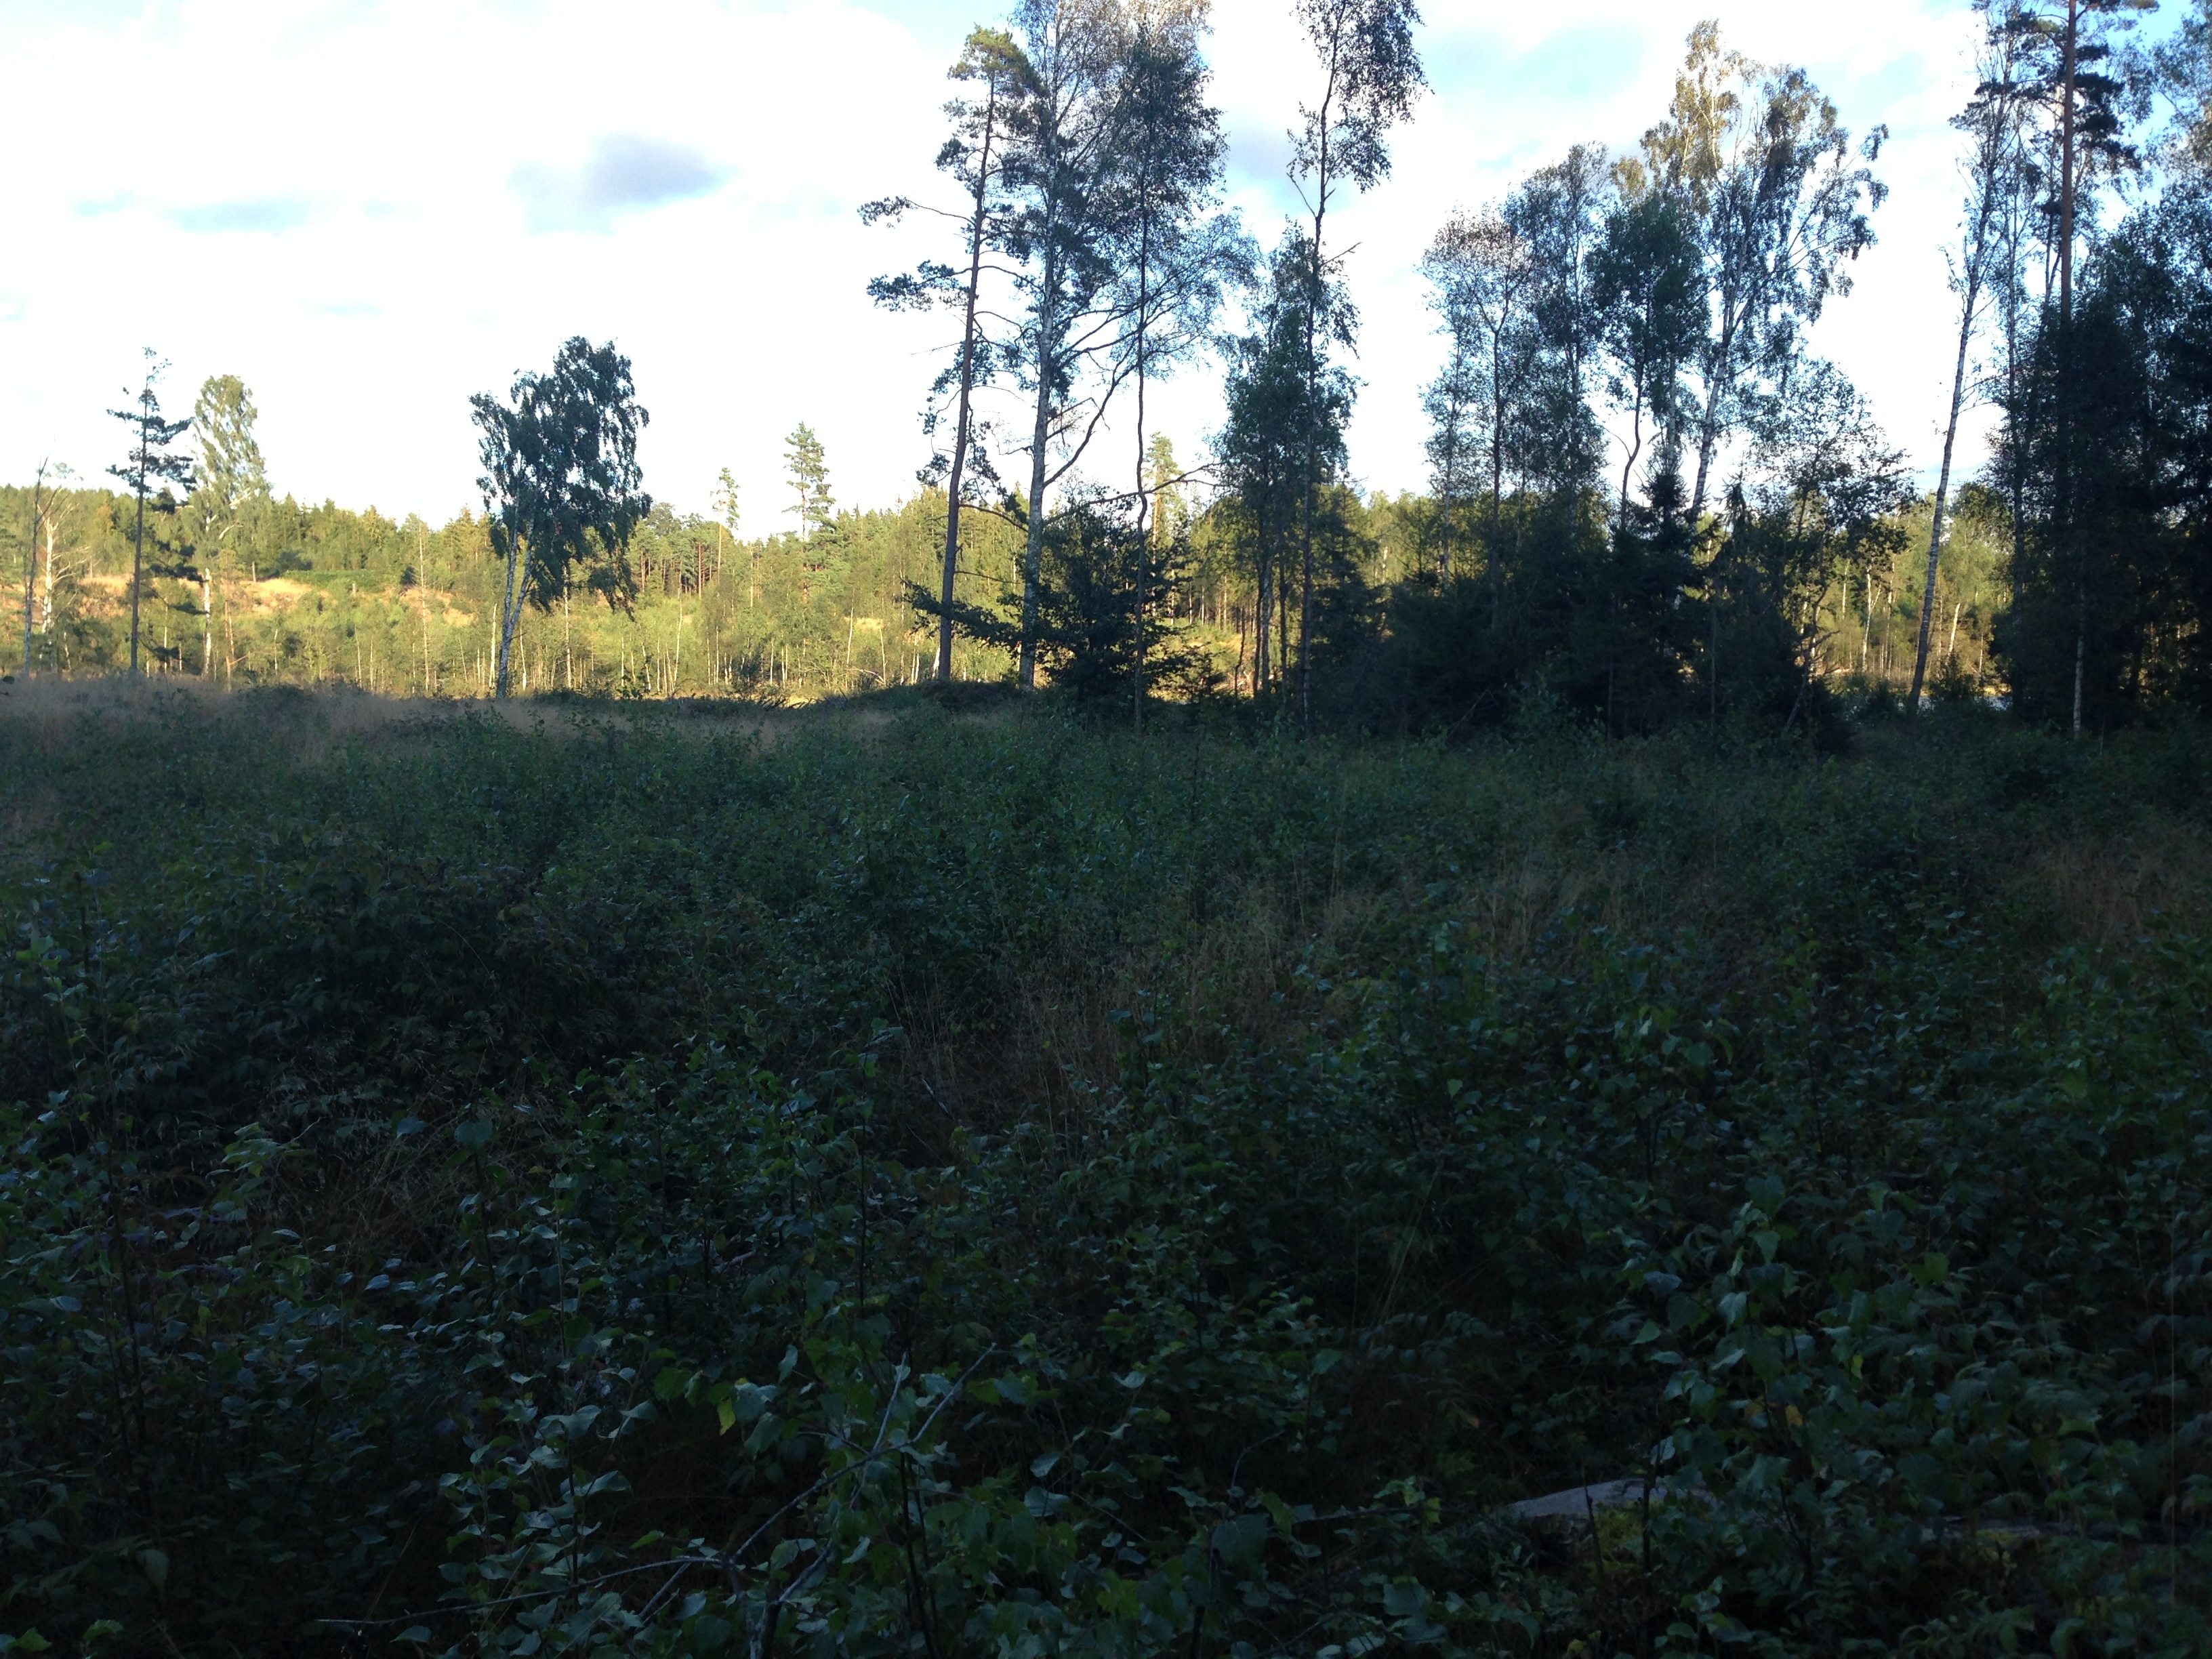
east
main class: Woodland
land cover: Spruce dominated mixed woodland
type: boreal forest
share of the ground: 50 - 75 %
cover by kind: broadleaved forest trees 40 %, coniferous forest trees 25 %, shrubs 25 %, herbaceous plants 10 %
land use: Forestry
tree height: < 5 m
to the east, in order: Spruce dominated mixed woodland; Broadleaved woodland; Inland fresh water bodies; Broadleaved woodland; Other bare soil; Tracks; Broadleaved woodland; Grassland with sparse tree/shrub cover
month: September
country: SE
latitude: 57.2448
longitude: 13.2275
